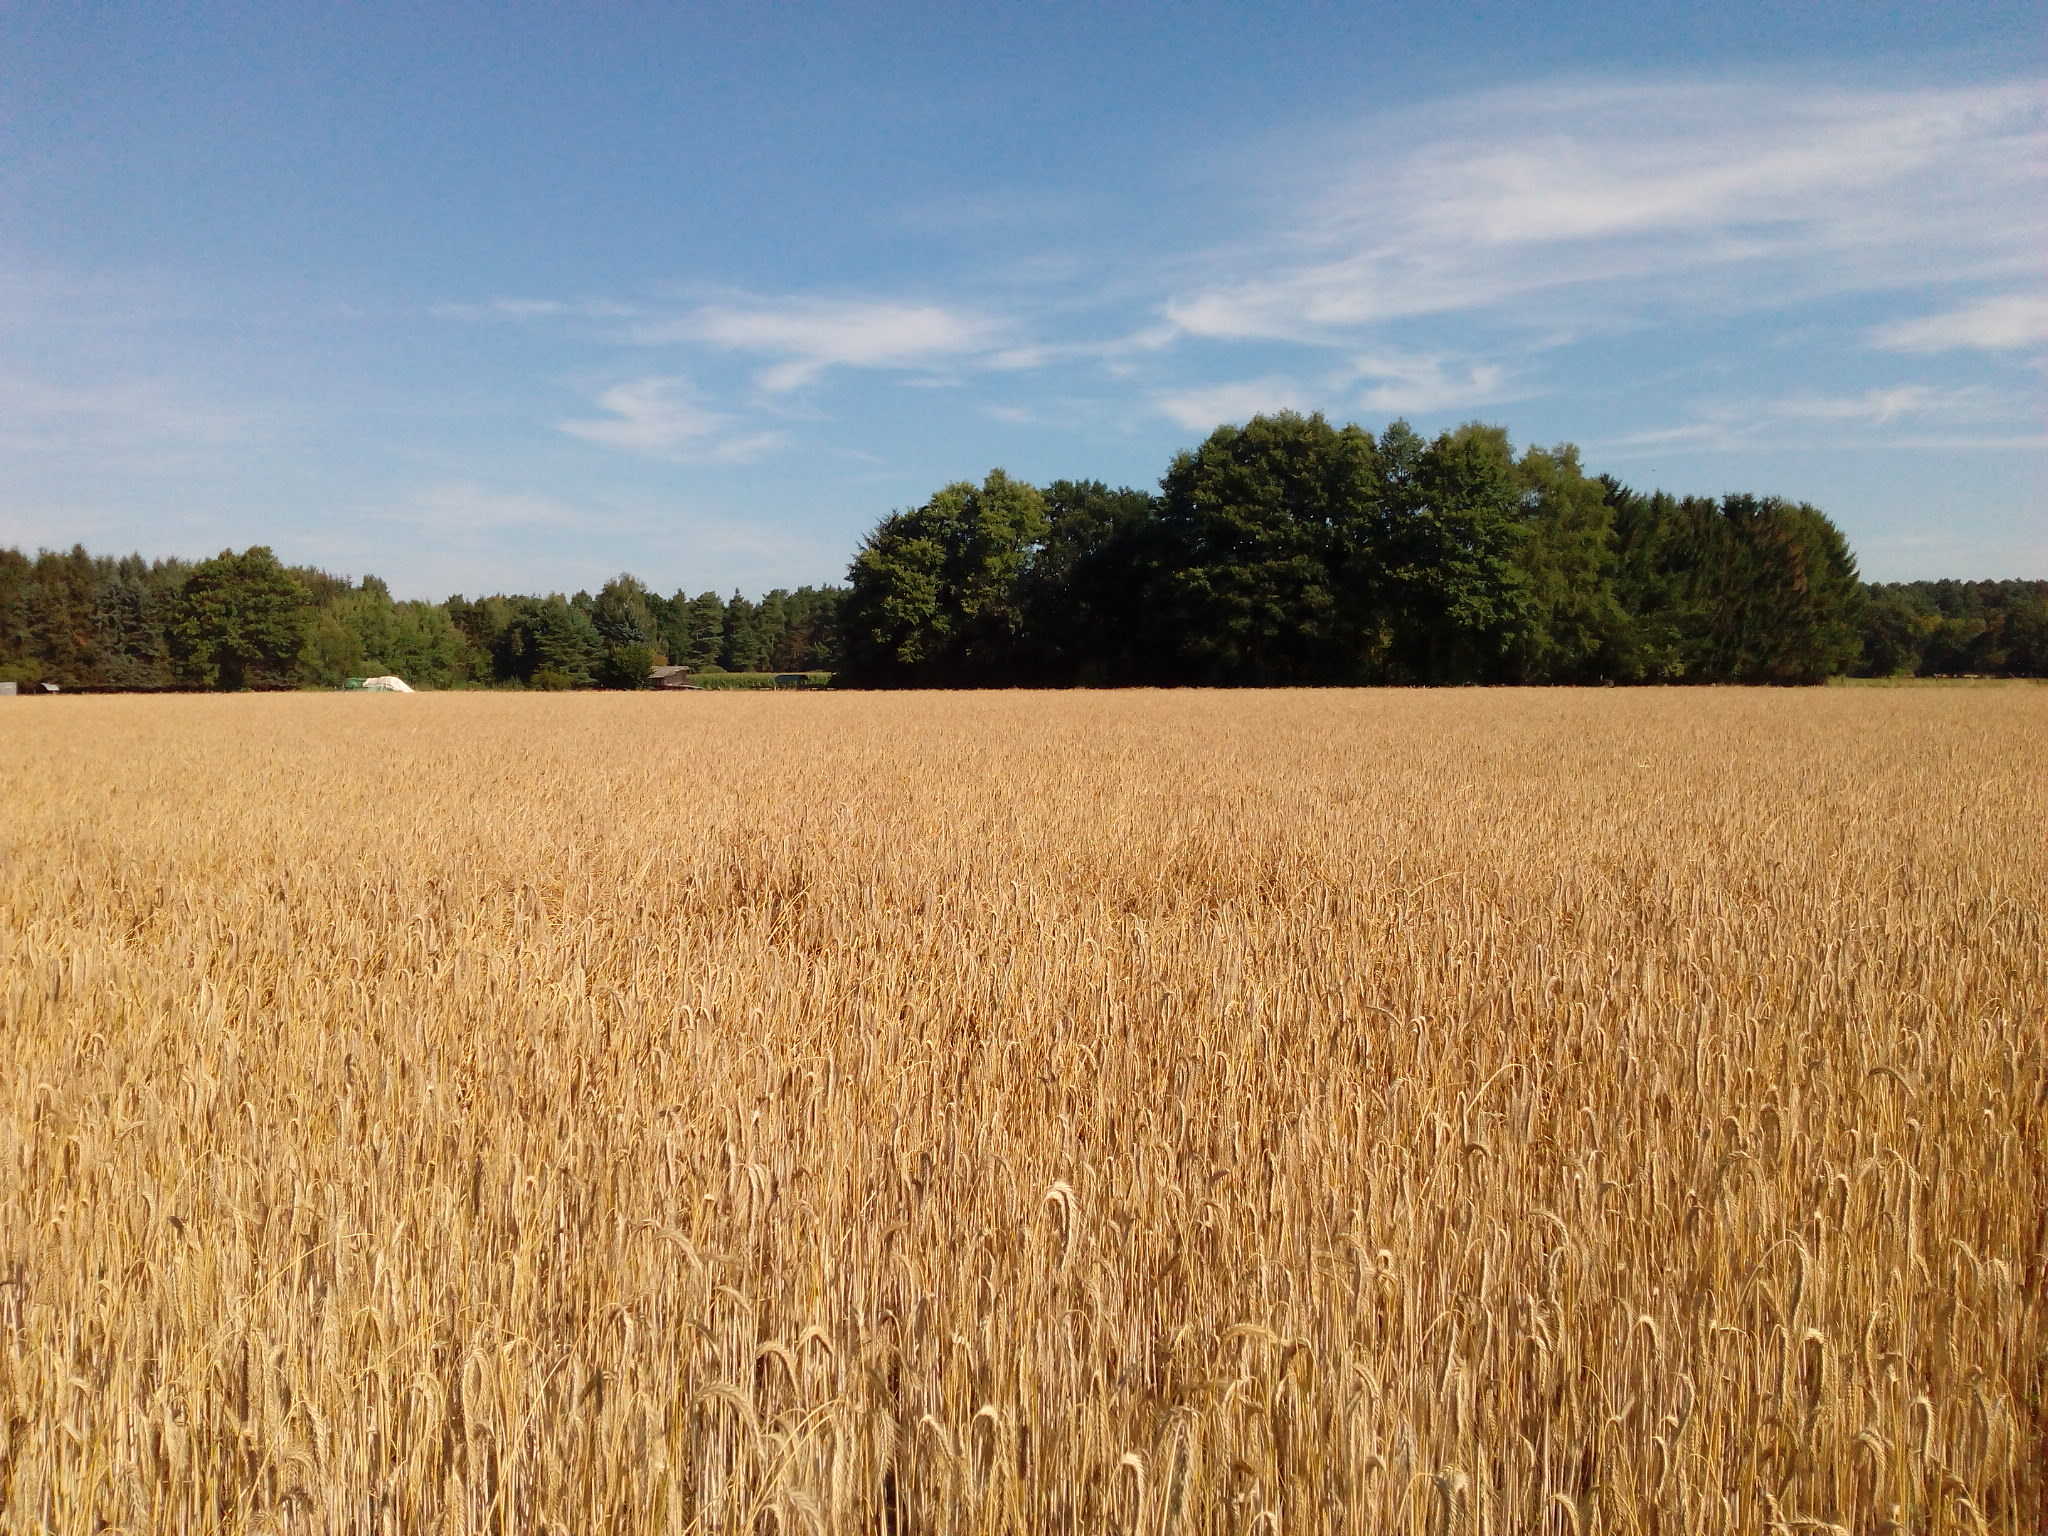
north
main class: Cropland
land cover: Rye
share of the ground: > 75 %
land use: Agriculture (excluding fallow land and kitchen gardens)
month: August
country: DE
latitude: 52.5212
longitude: 9.8969
